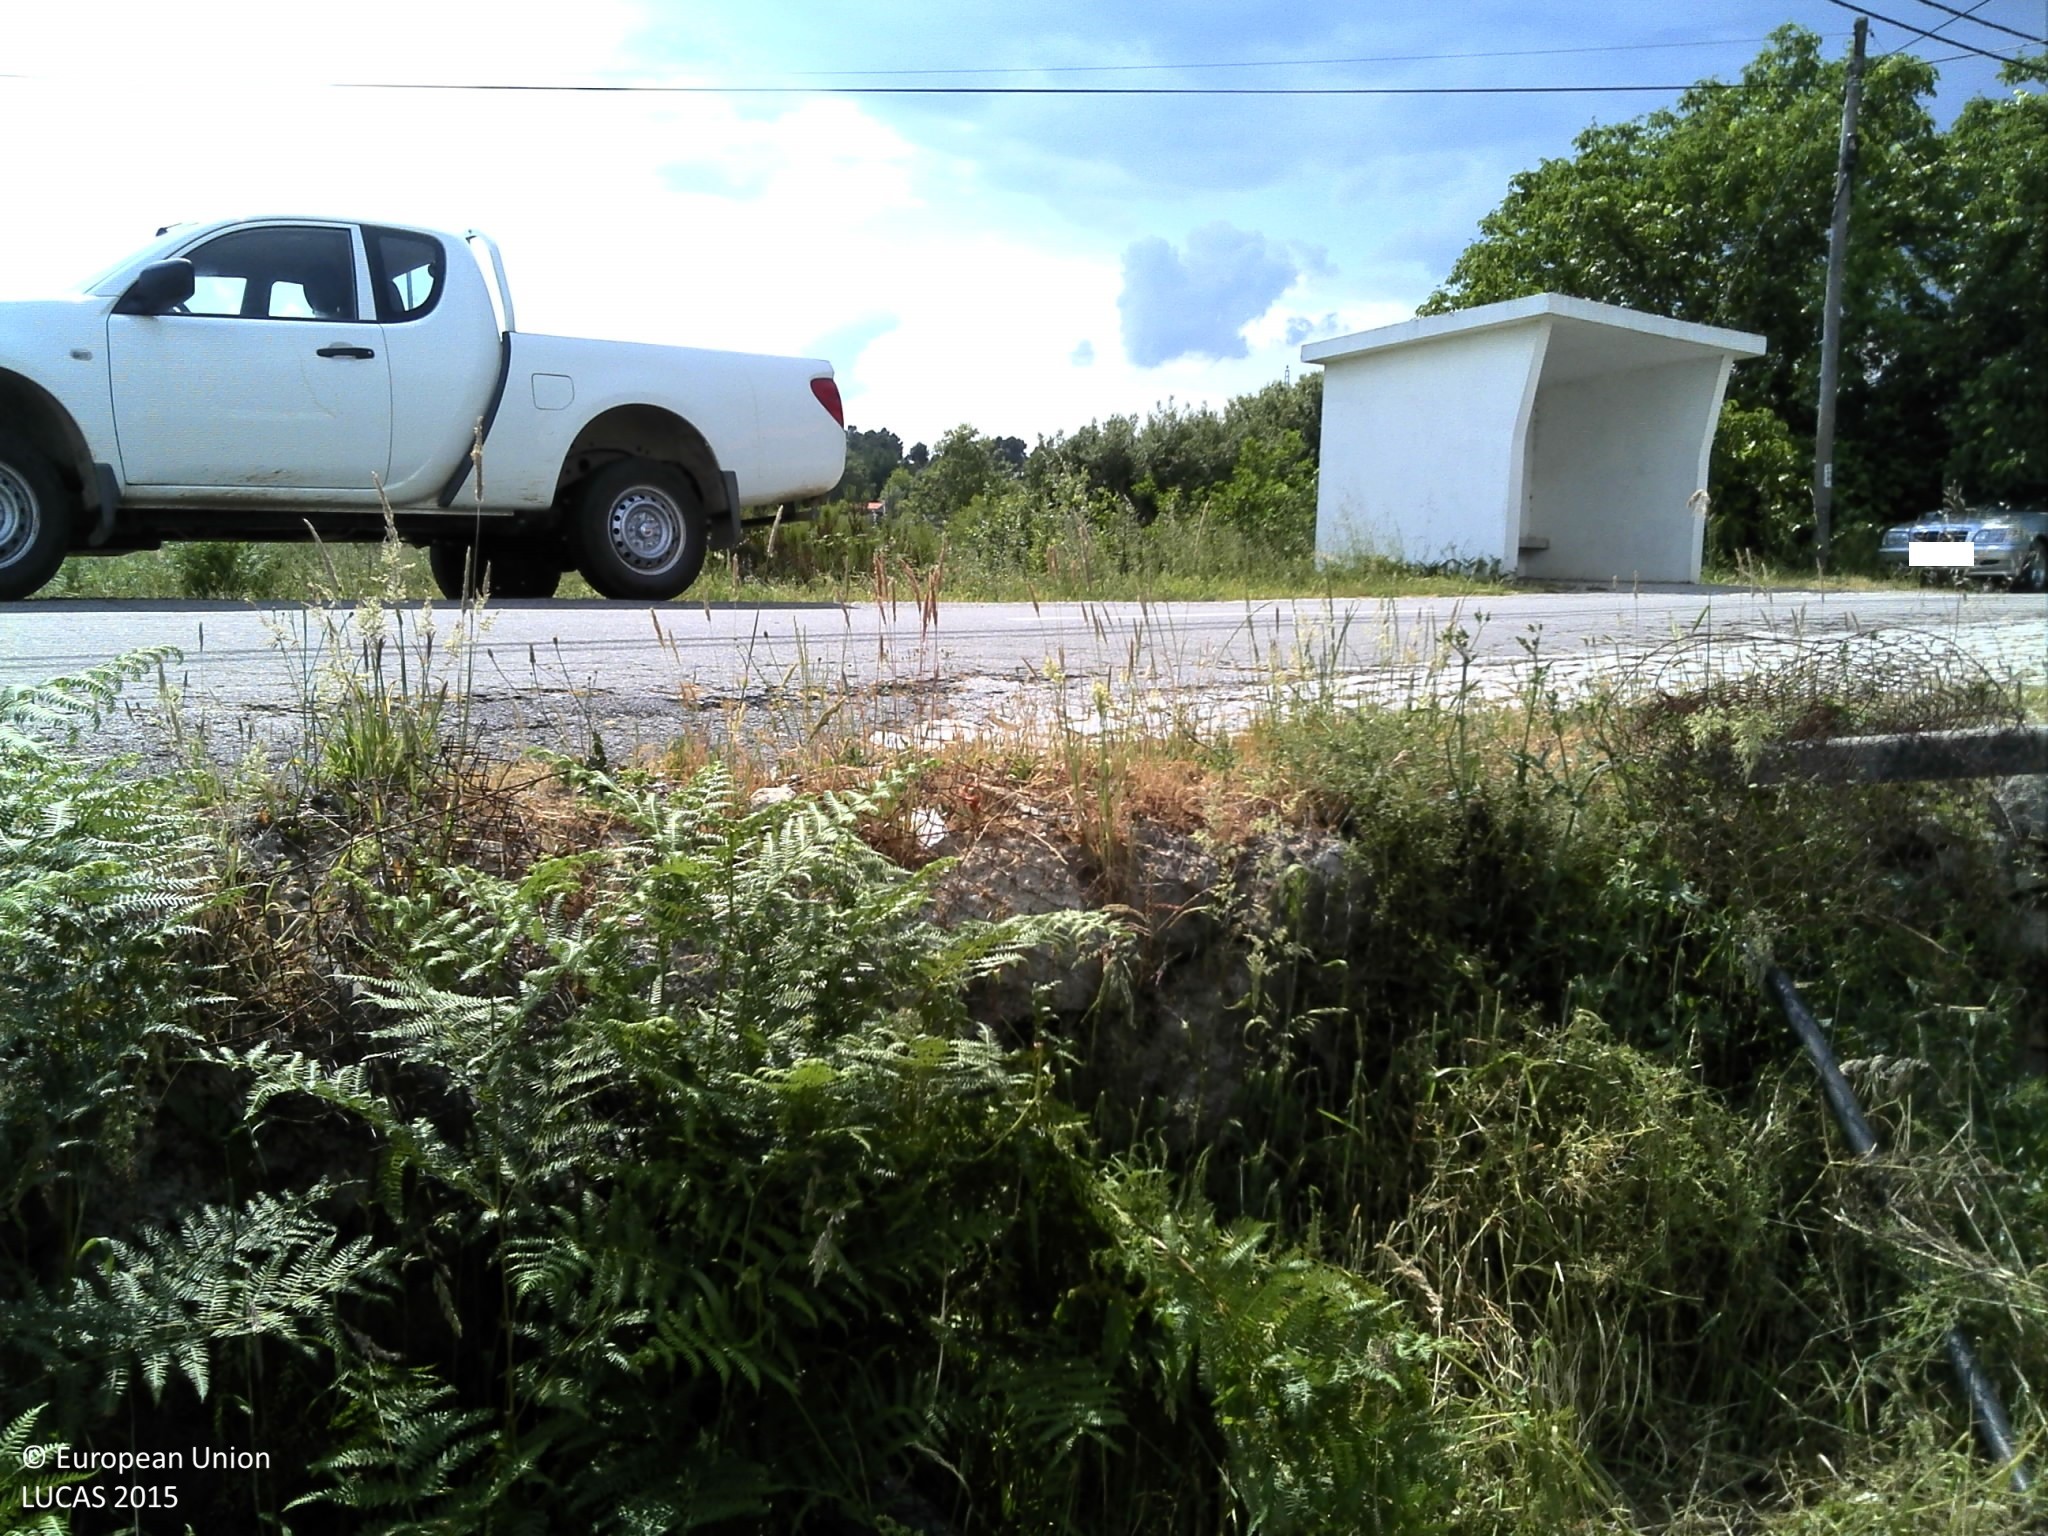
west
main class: Grassland
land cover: Grassland without tree/shrub cover
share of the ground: > 75 %
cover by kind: herbaceous plants 95 %, shrubs 5 %
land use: Agriculture (excluding fallow land and kitchen gardens)
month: June
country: PT
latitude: 41.3323
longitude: -7.6329
